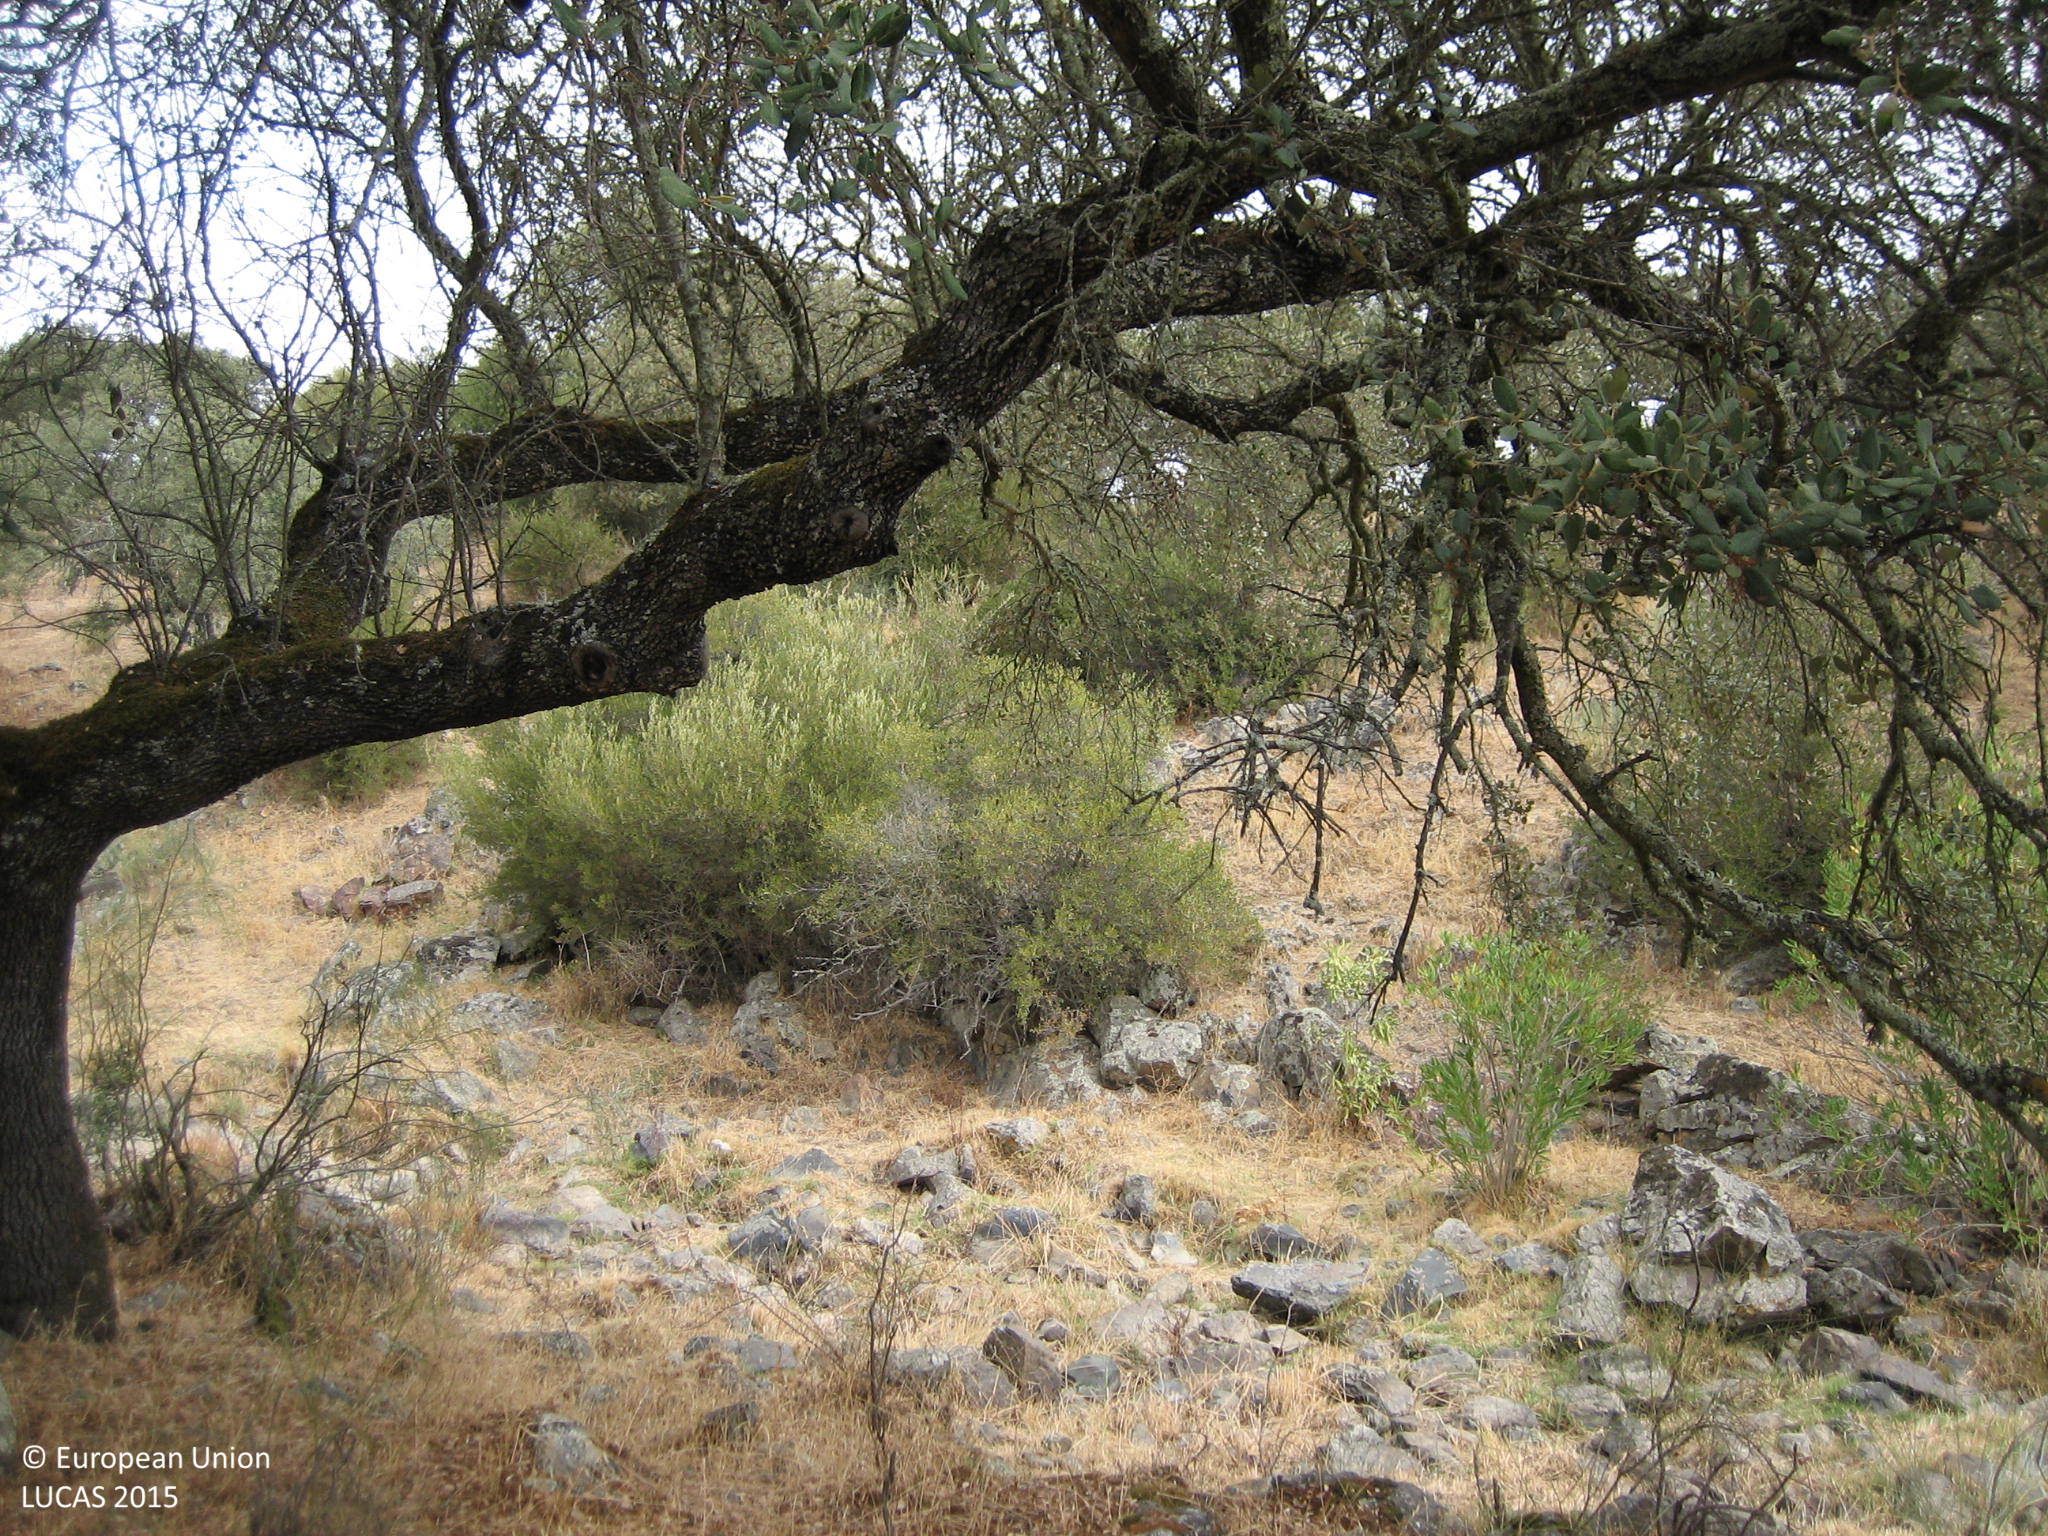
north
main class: Woodland
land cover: Broadleaved woodland
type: broadleaved evergreen forest
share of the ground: 25 - 50 %
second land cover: Shrubland without tree cover
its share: 10 - 25 %
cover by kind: herbaceous plants 55 %, broadleaved forest trees 30 %, shrubs 15 %
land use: Forestry
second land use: Agriculture (excluding fallow land and kitchen gardens)
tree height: > 5 m
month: September
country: ES
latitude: 38.5639
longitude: -6.9221
